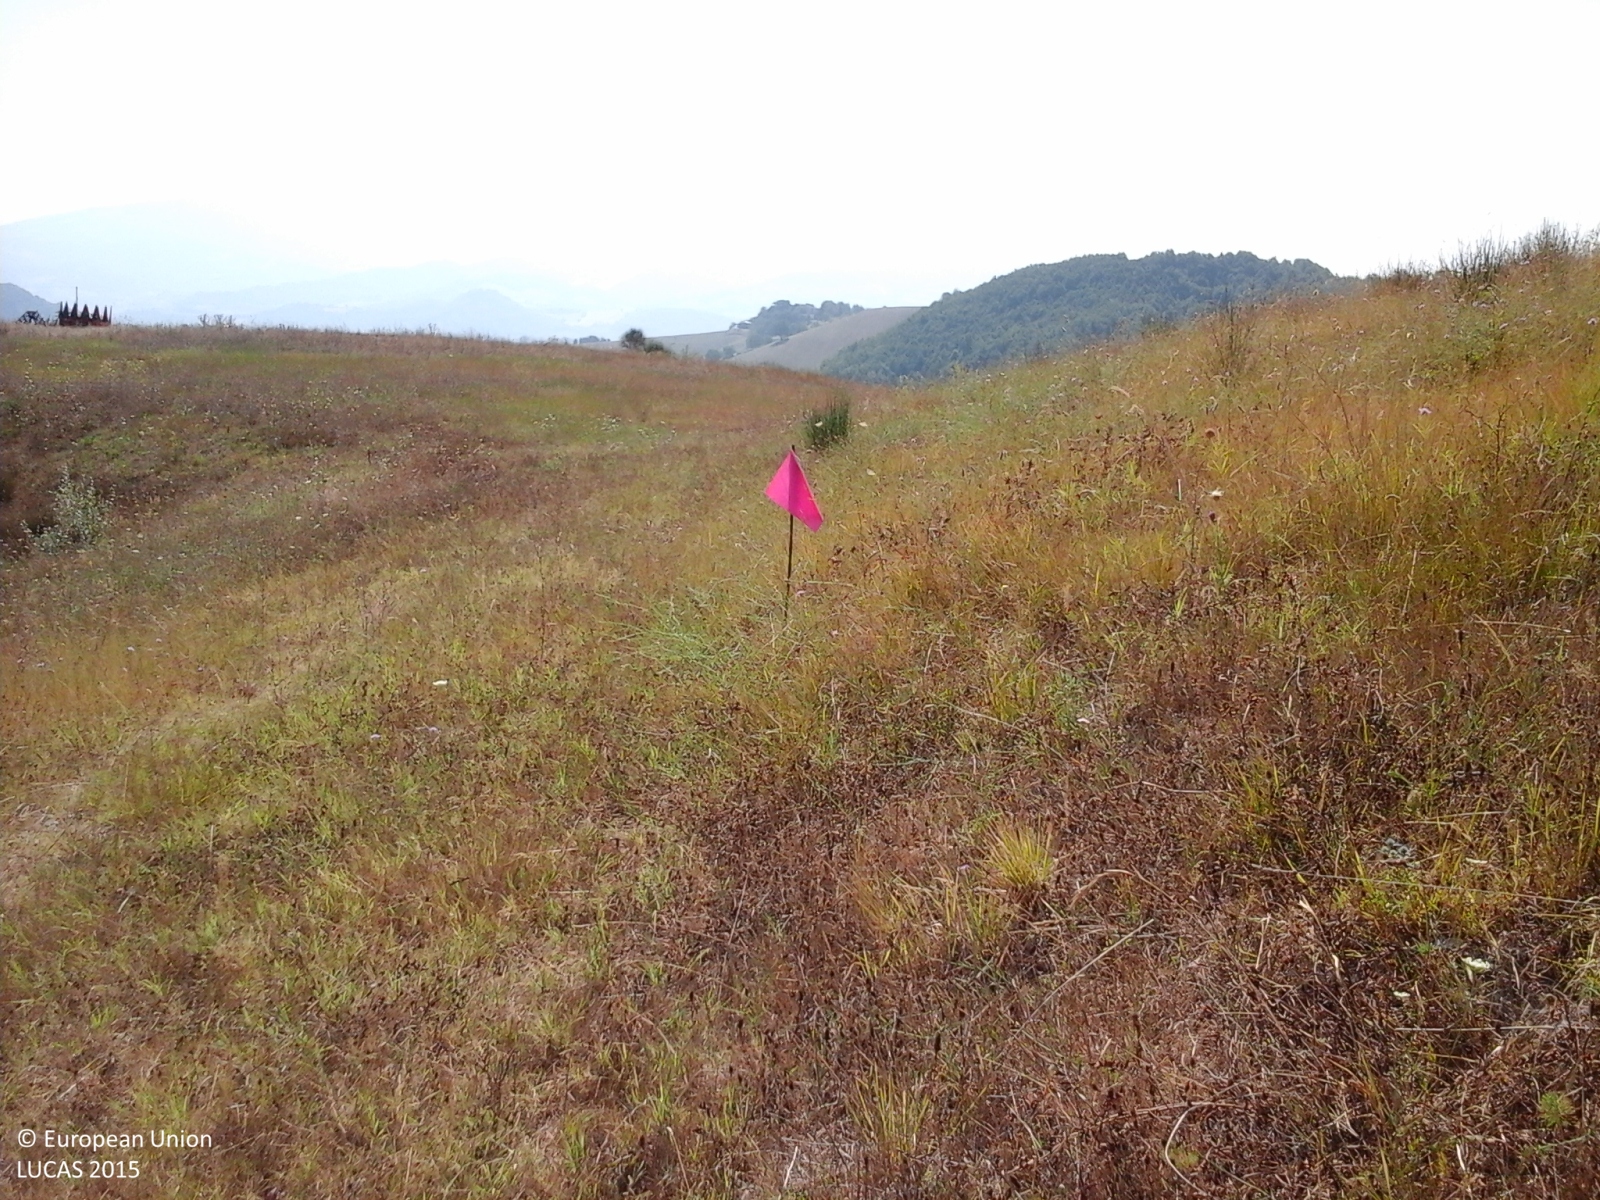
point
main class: Grassland
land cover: Grassland with sparse tree/shrub cover
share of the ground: > 75 %
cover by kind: herbaceous plants 85 %, shrubs 10 %, broadleaved forest trees 5 %
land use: Semi-natural and natural areas not in use
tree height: < 5 m
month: August
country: IT
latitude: 43.6692
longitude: 12.5608
